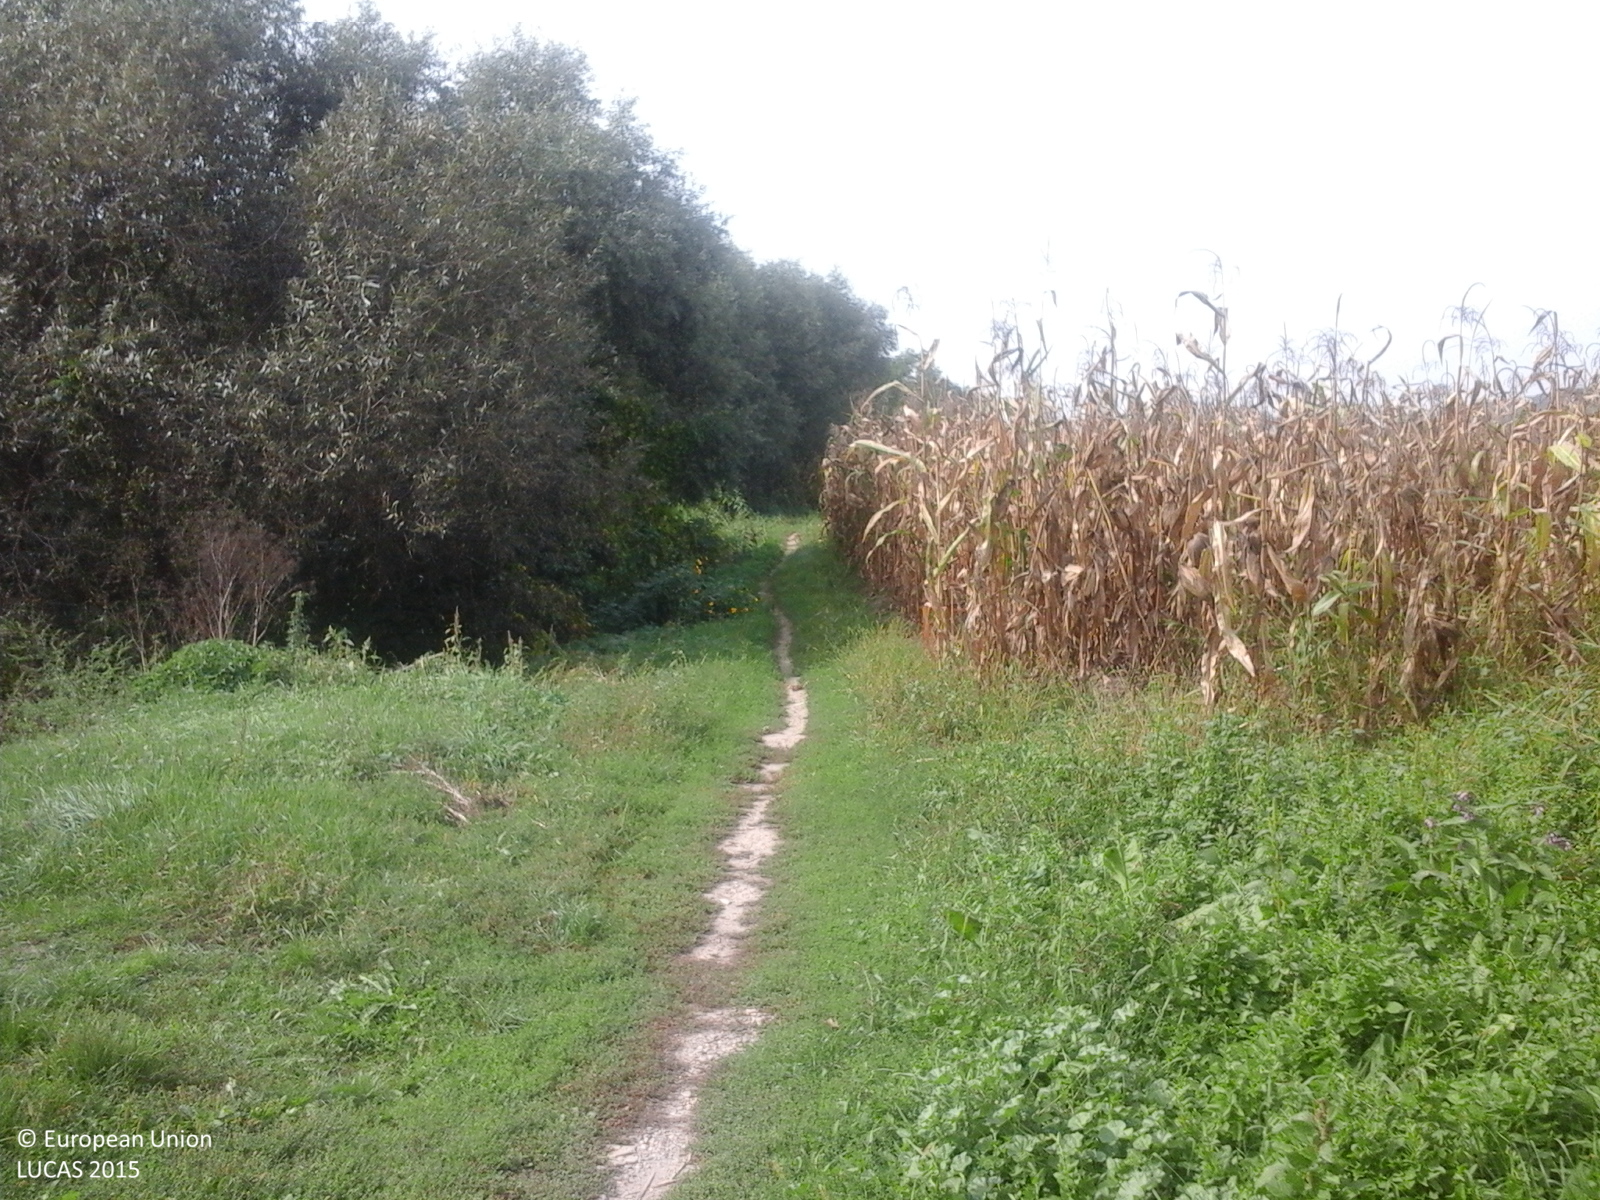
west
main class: Grassland
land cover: Spontaneously vegetated surfaces
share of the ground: > 75 %
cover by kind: herbaceous plants 100 %
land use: Fallow land
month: September
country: RO
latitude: 46.9294
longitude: 23.6670
